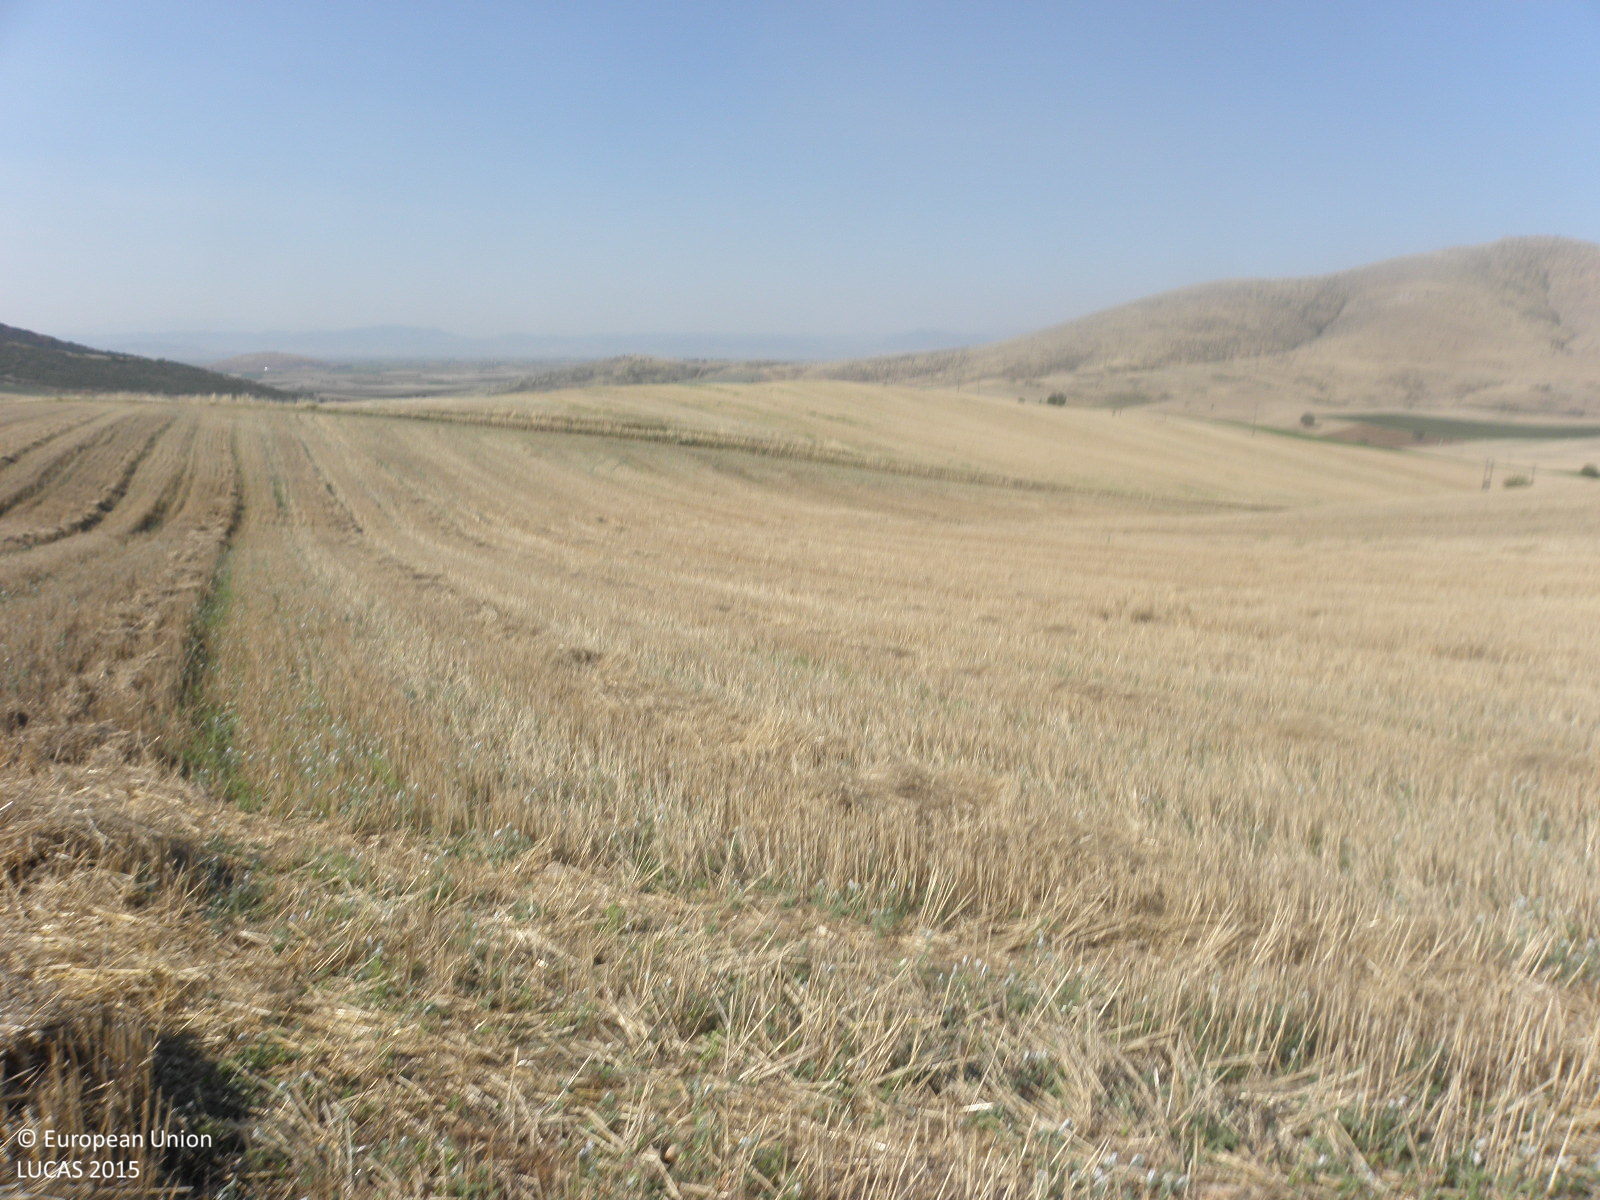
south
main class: Cropland
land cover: Durum wheat
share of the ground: > 75 %
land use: Agriculture (excluding fallow land and kitchen gardens)
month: July
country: GR
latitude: 39.4366
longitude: 22.2901
